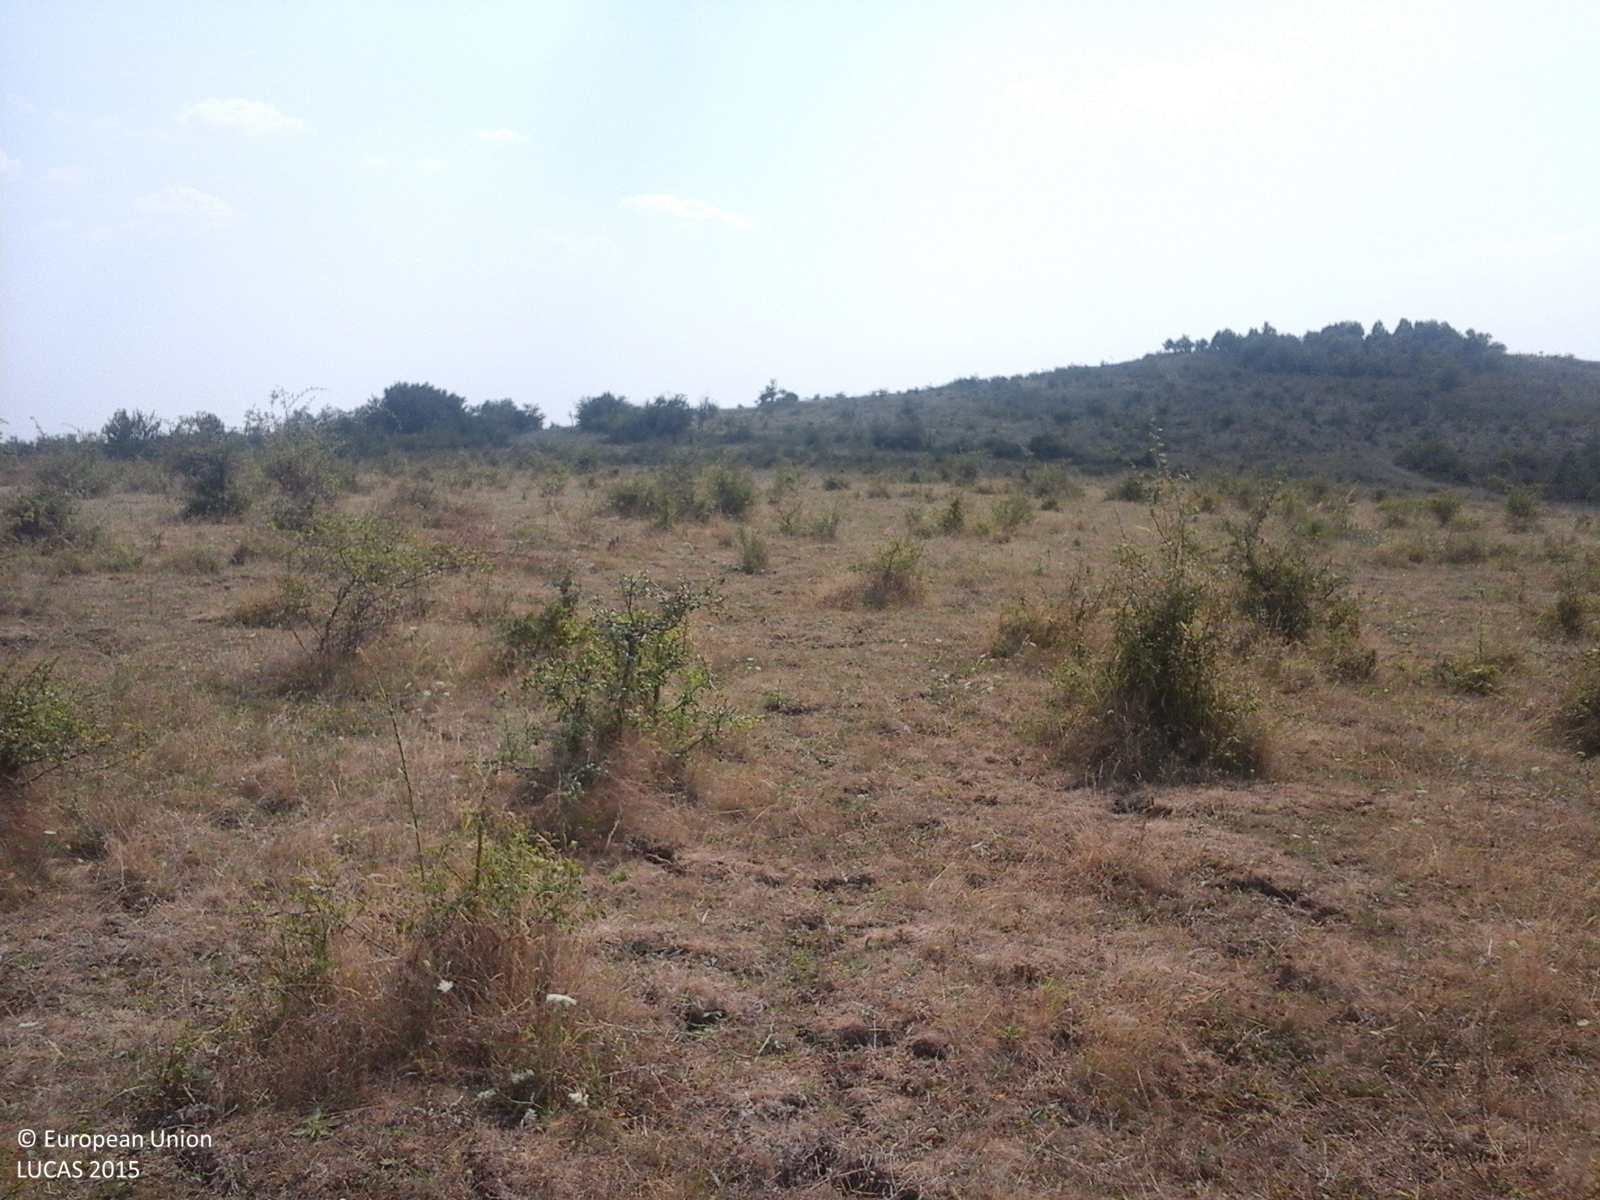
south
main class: Grassland
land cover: Grassland with sparse tree/shrub cover
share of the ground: > 75 %
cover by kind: herbaceous plants 85 %, shrubs 10 %, broadleaved forest trees 5 %
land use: Fallow land
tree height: < 5 m
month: August
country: RO
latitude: 44.6364
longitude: 23.0444
